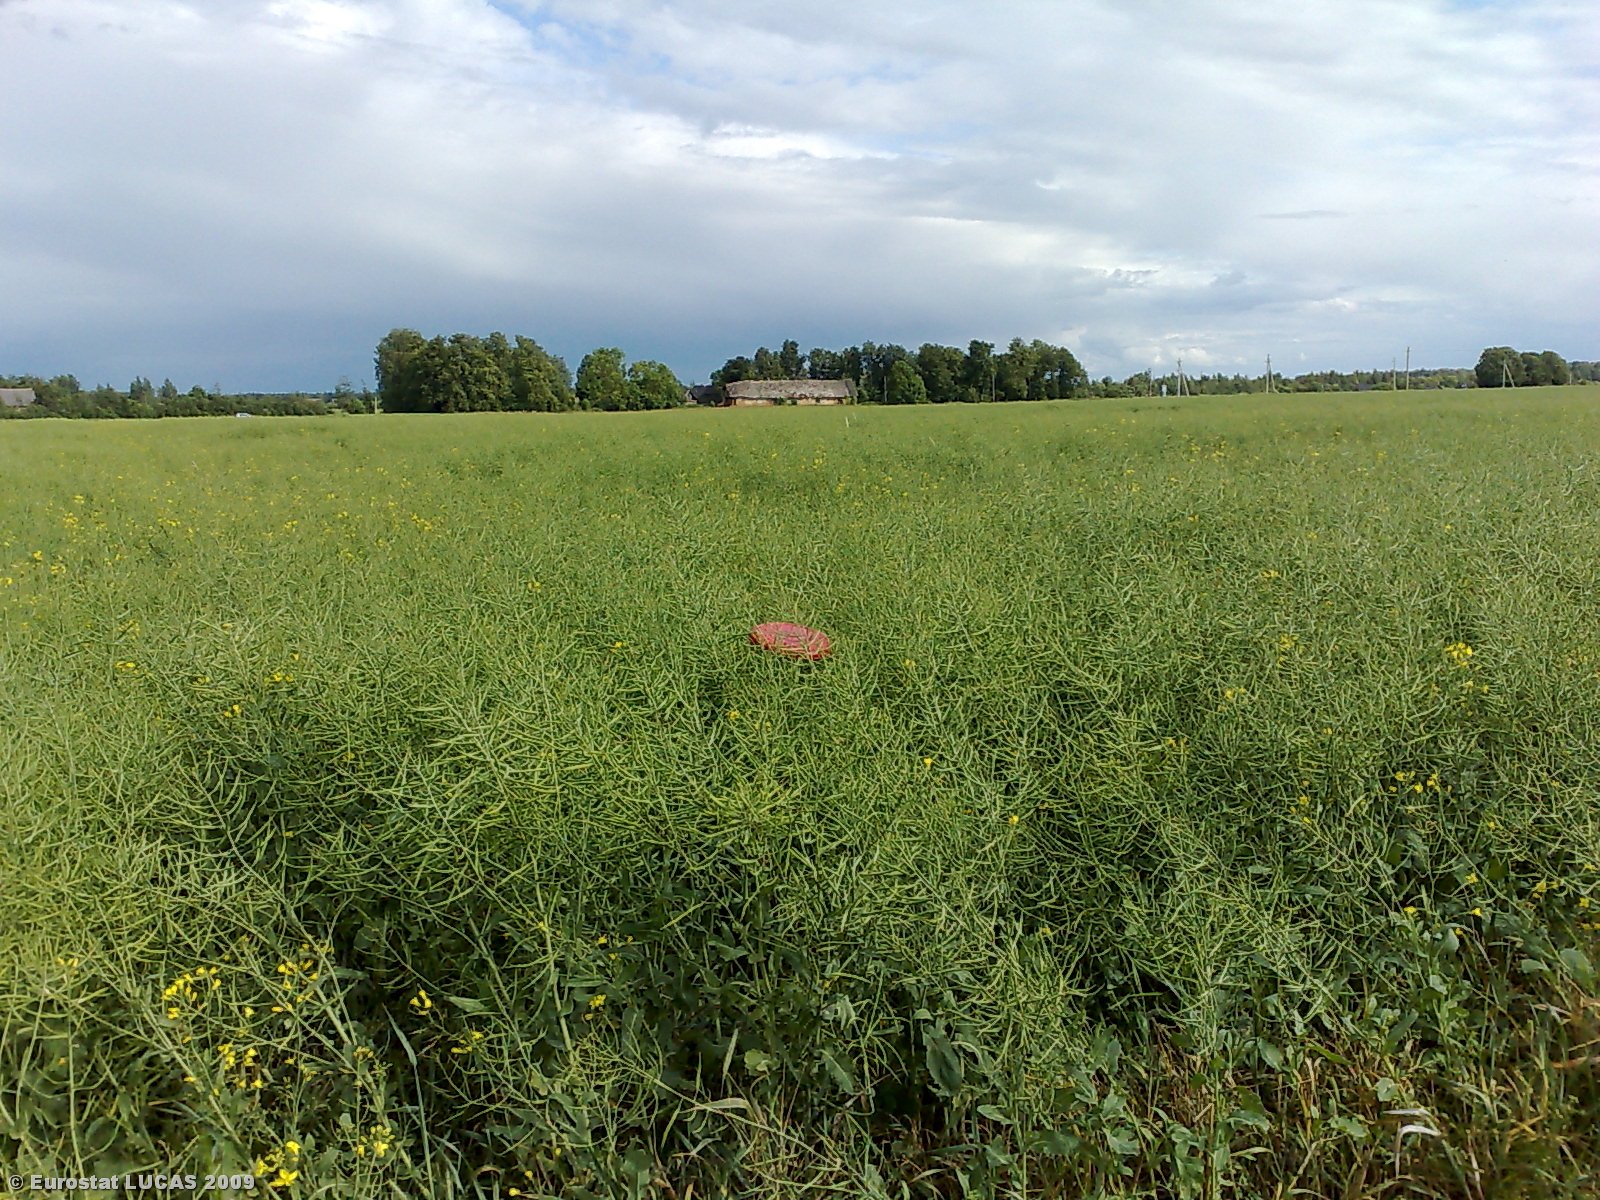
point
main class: Cropland
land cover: Rape and turnip rape
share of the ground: > 75 %
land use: Agriculture (excluding fallow land and kitchen gardens)
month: June
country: LT
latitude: 56.0116
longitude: 23.8951
